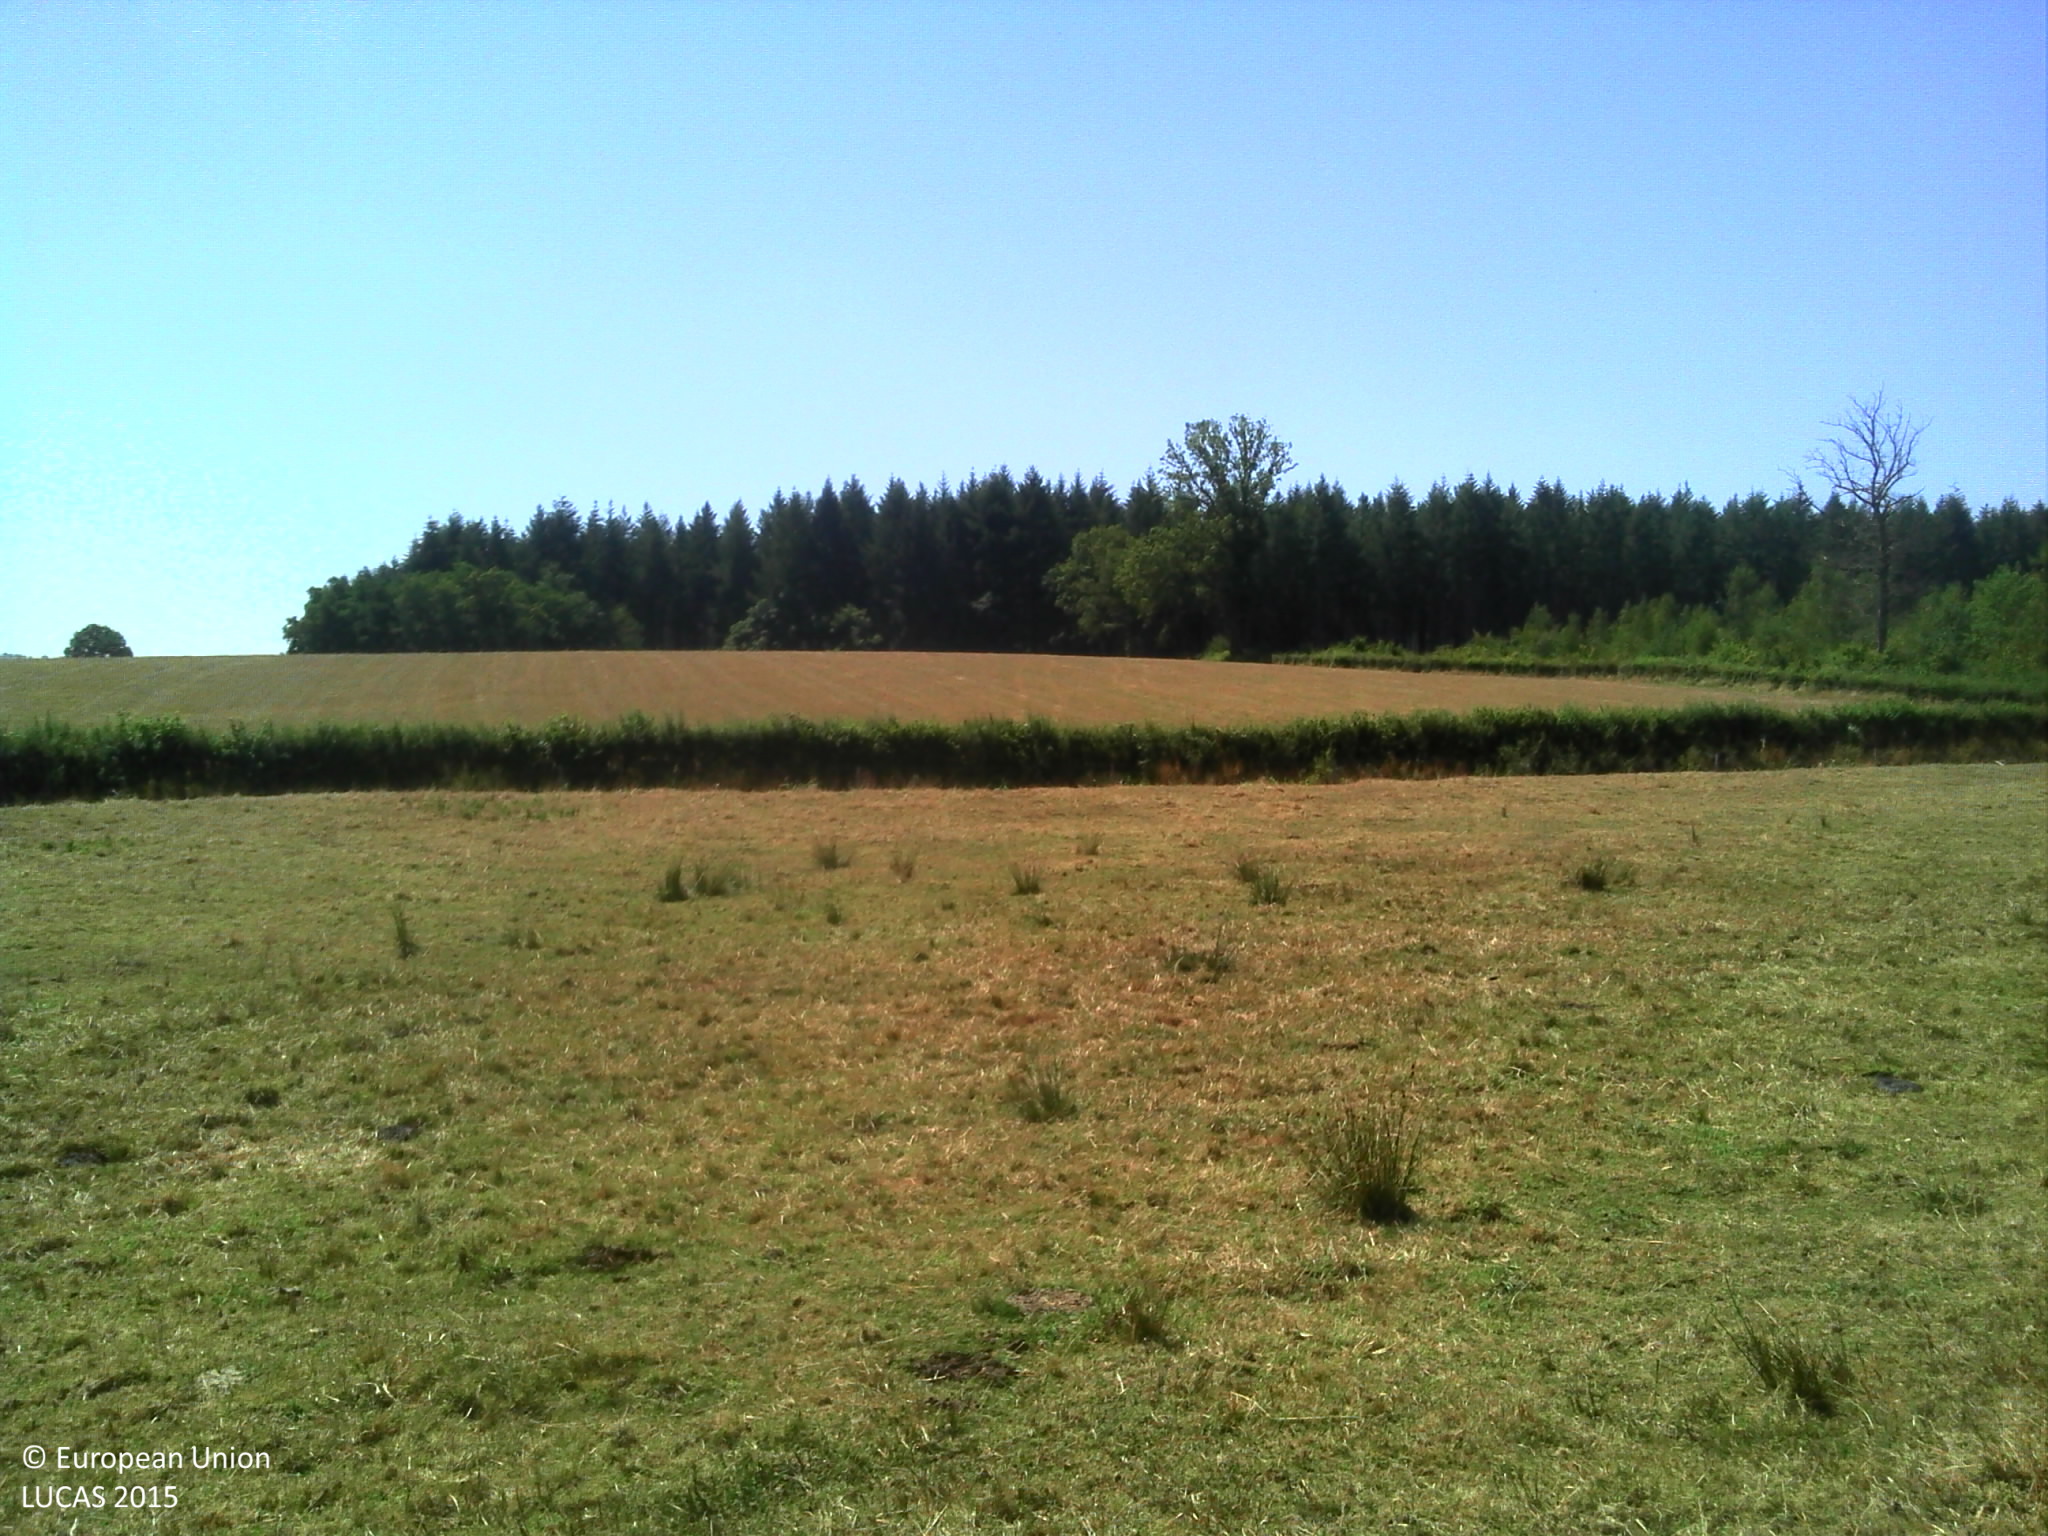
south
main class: Grassland
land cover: Grassland without tree/shrub cover
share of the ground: > 75 %
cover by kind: herbaceous plants 100 %
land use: Agriculture (excluding fallow land and kitchen gardens)
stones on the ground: 10 - 25 %
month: August
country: FR
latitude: 46.6775
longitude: 4.4710
